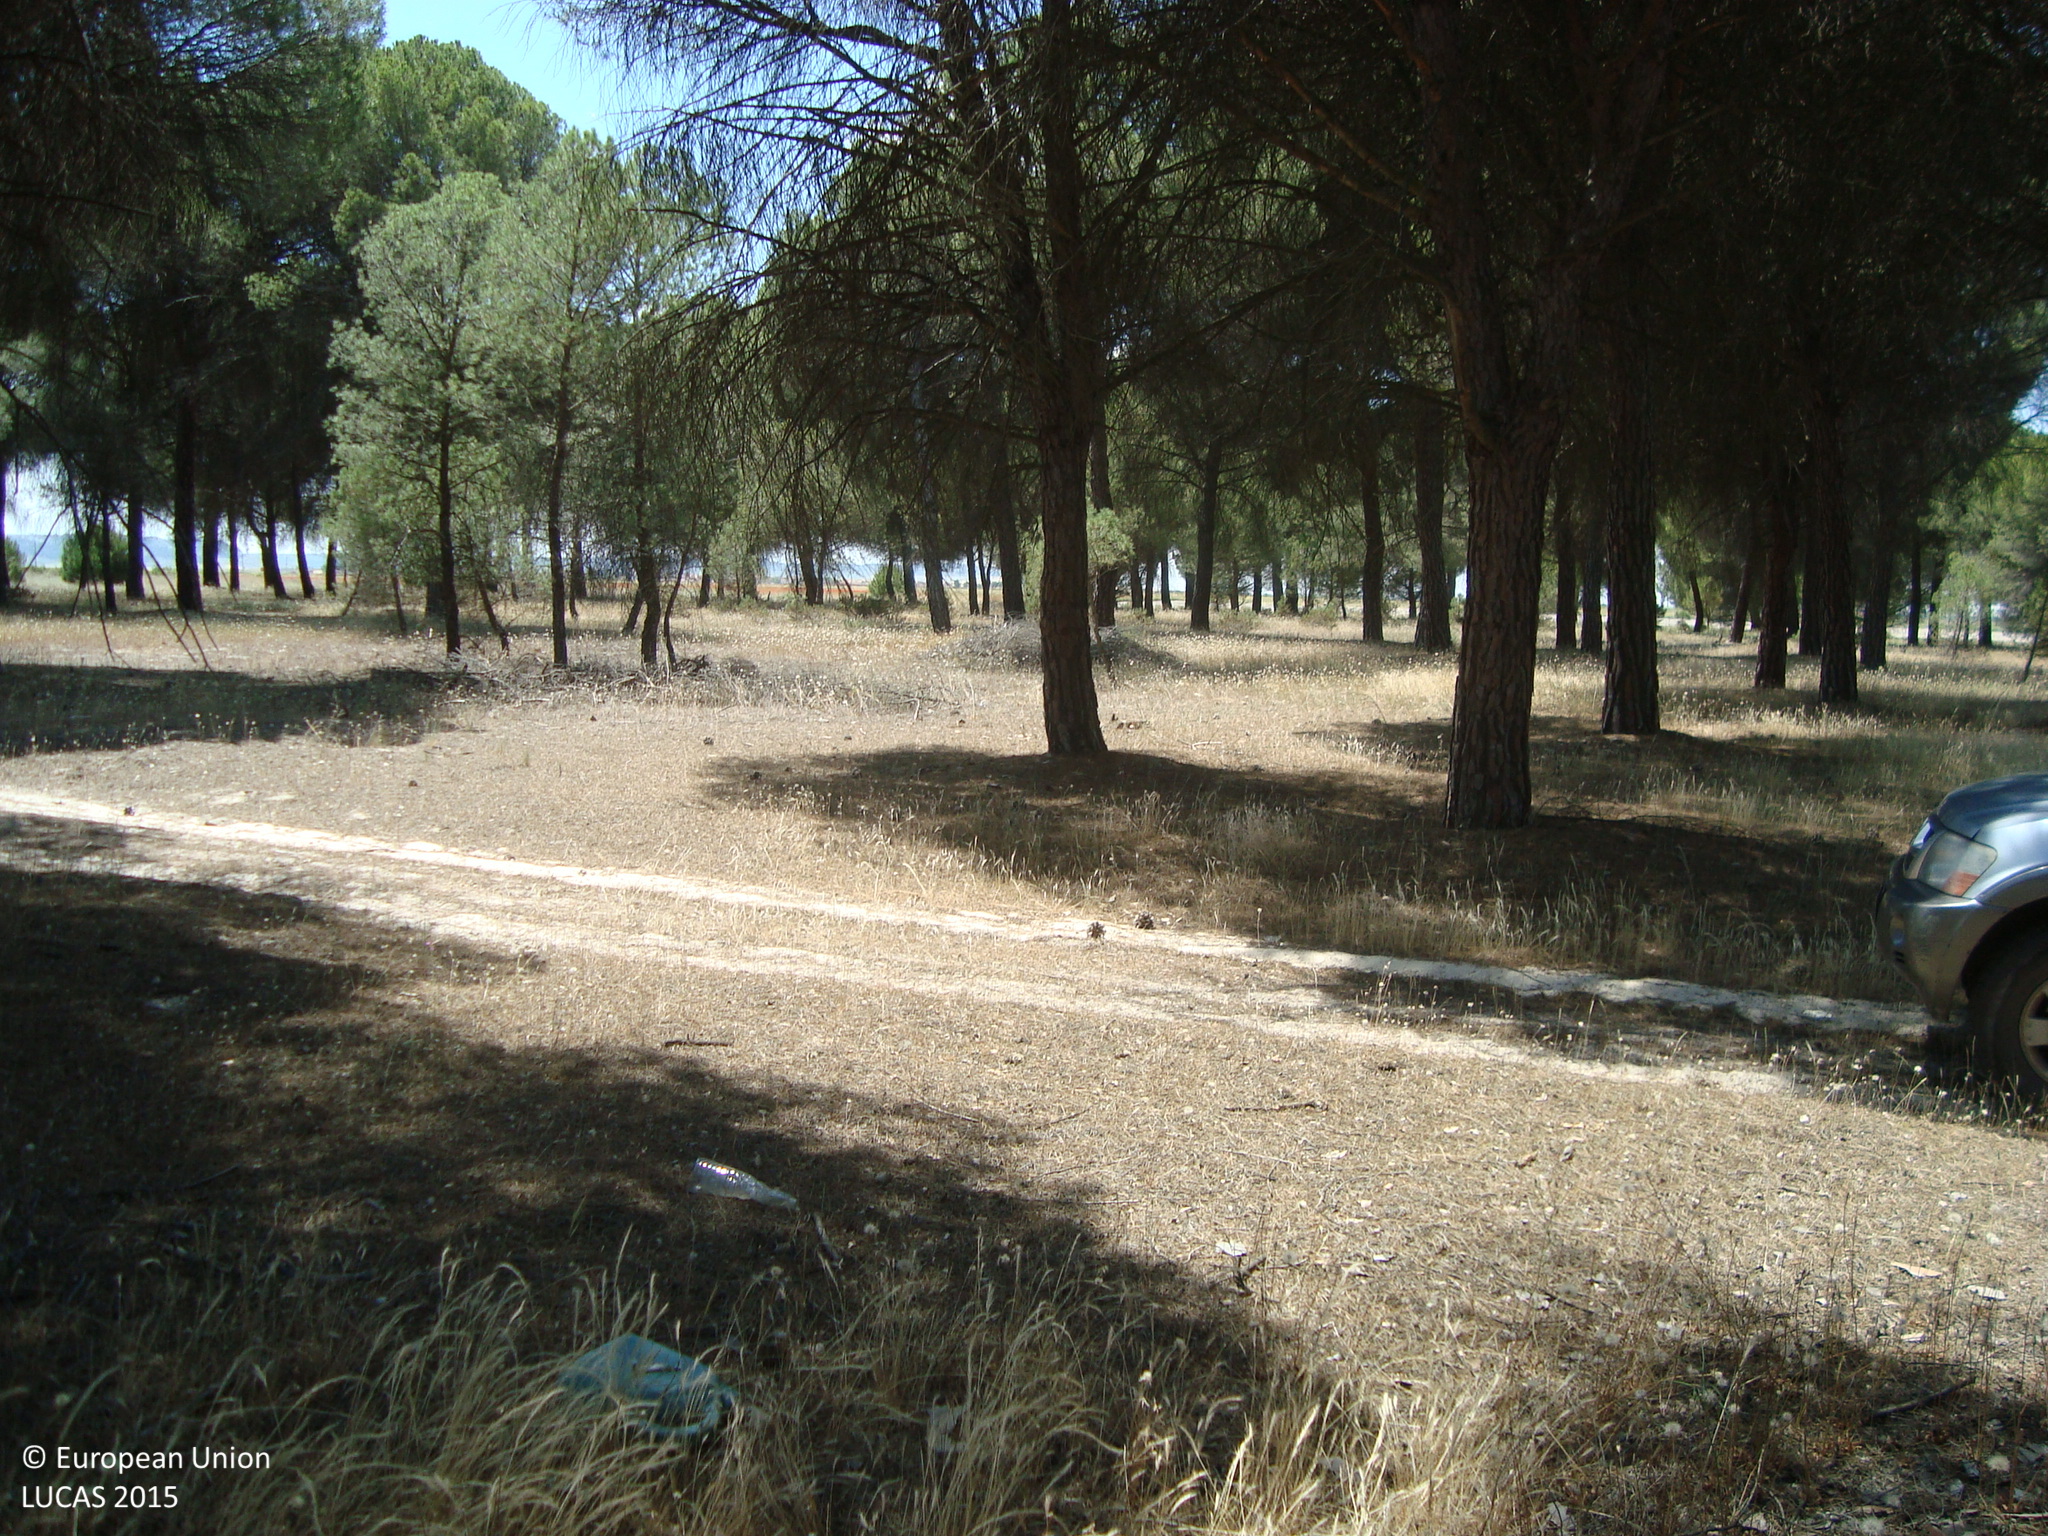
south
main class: Woodland
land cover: Pine dominated coniferous woodland
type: coniferous forest of the mediterranean region
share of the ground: 50 - 75 %
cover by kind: coniferous forest trees 60 %, herbaceous plants 30 %, unconsolidated bare surface 10 %
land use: Forestry
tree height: > 5 m
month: June
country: ES
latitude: 41.4916
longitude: -4.6428
